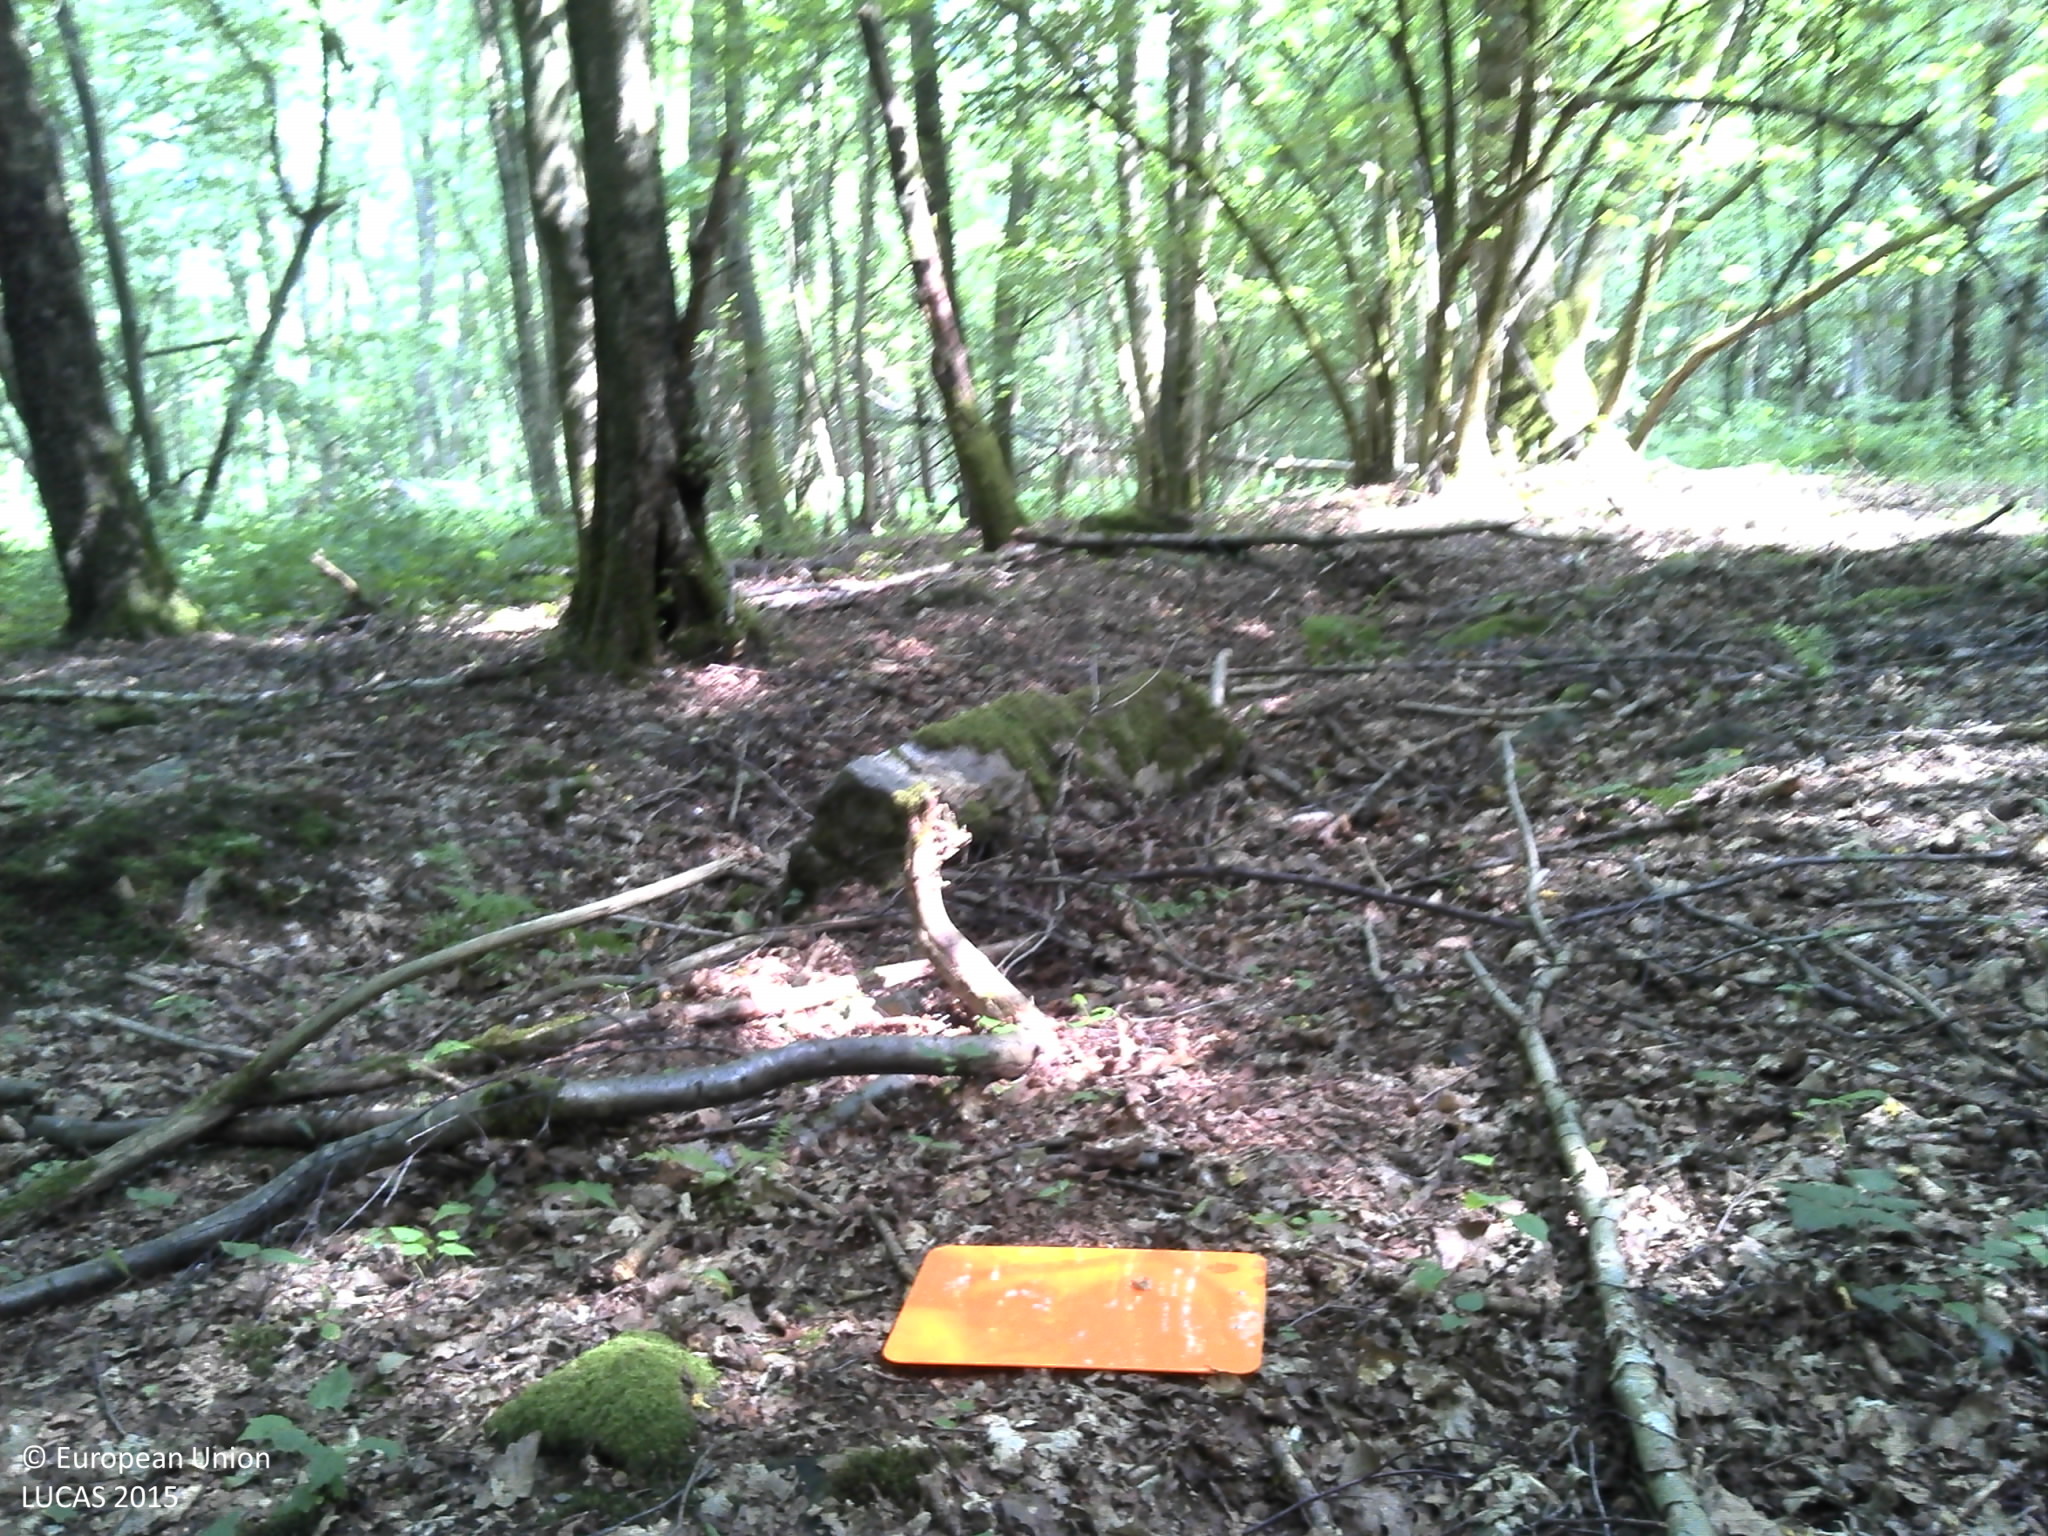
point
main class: Woodland
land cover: Broadleaved woodland
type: beech forest
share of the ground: 50 - 75 %
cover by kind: broadleaved forest trees 65 %, herbaceous plants 15 %, consolidated bare surface 15 %, lichens and mosses 5 %
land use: Forestry
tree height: > 5 m
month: July
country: FR
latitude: 49.9523
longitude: 4.6864
